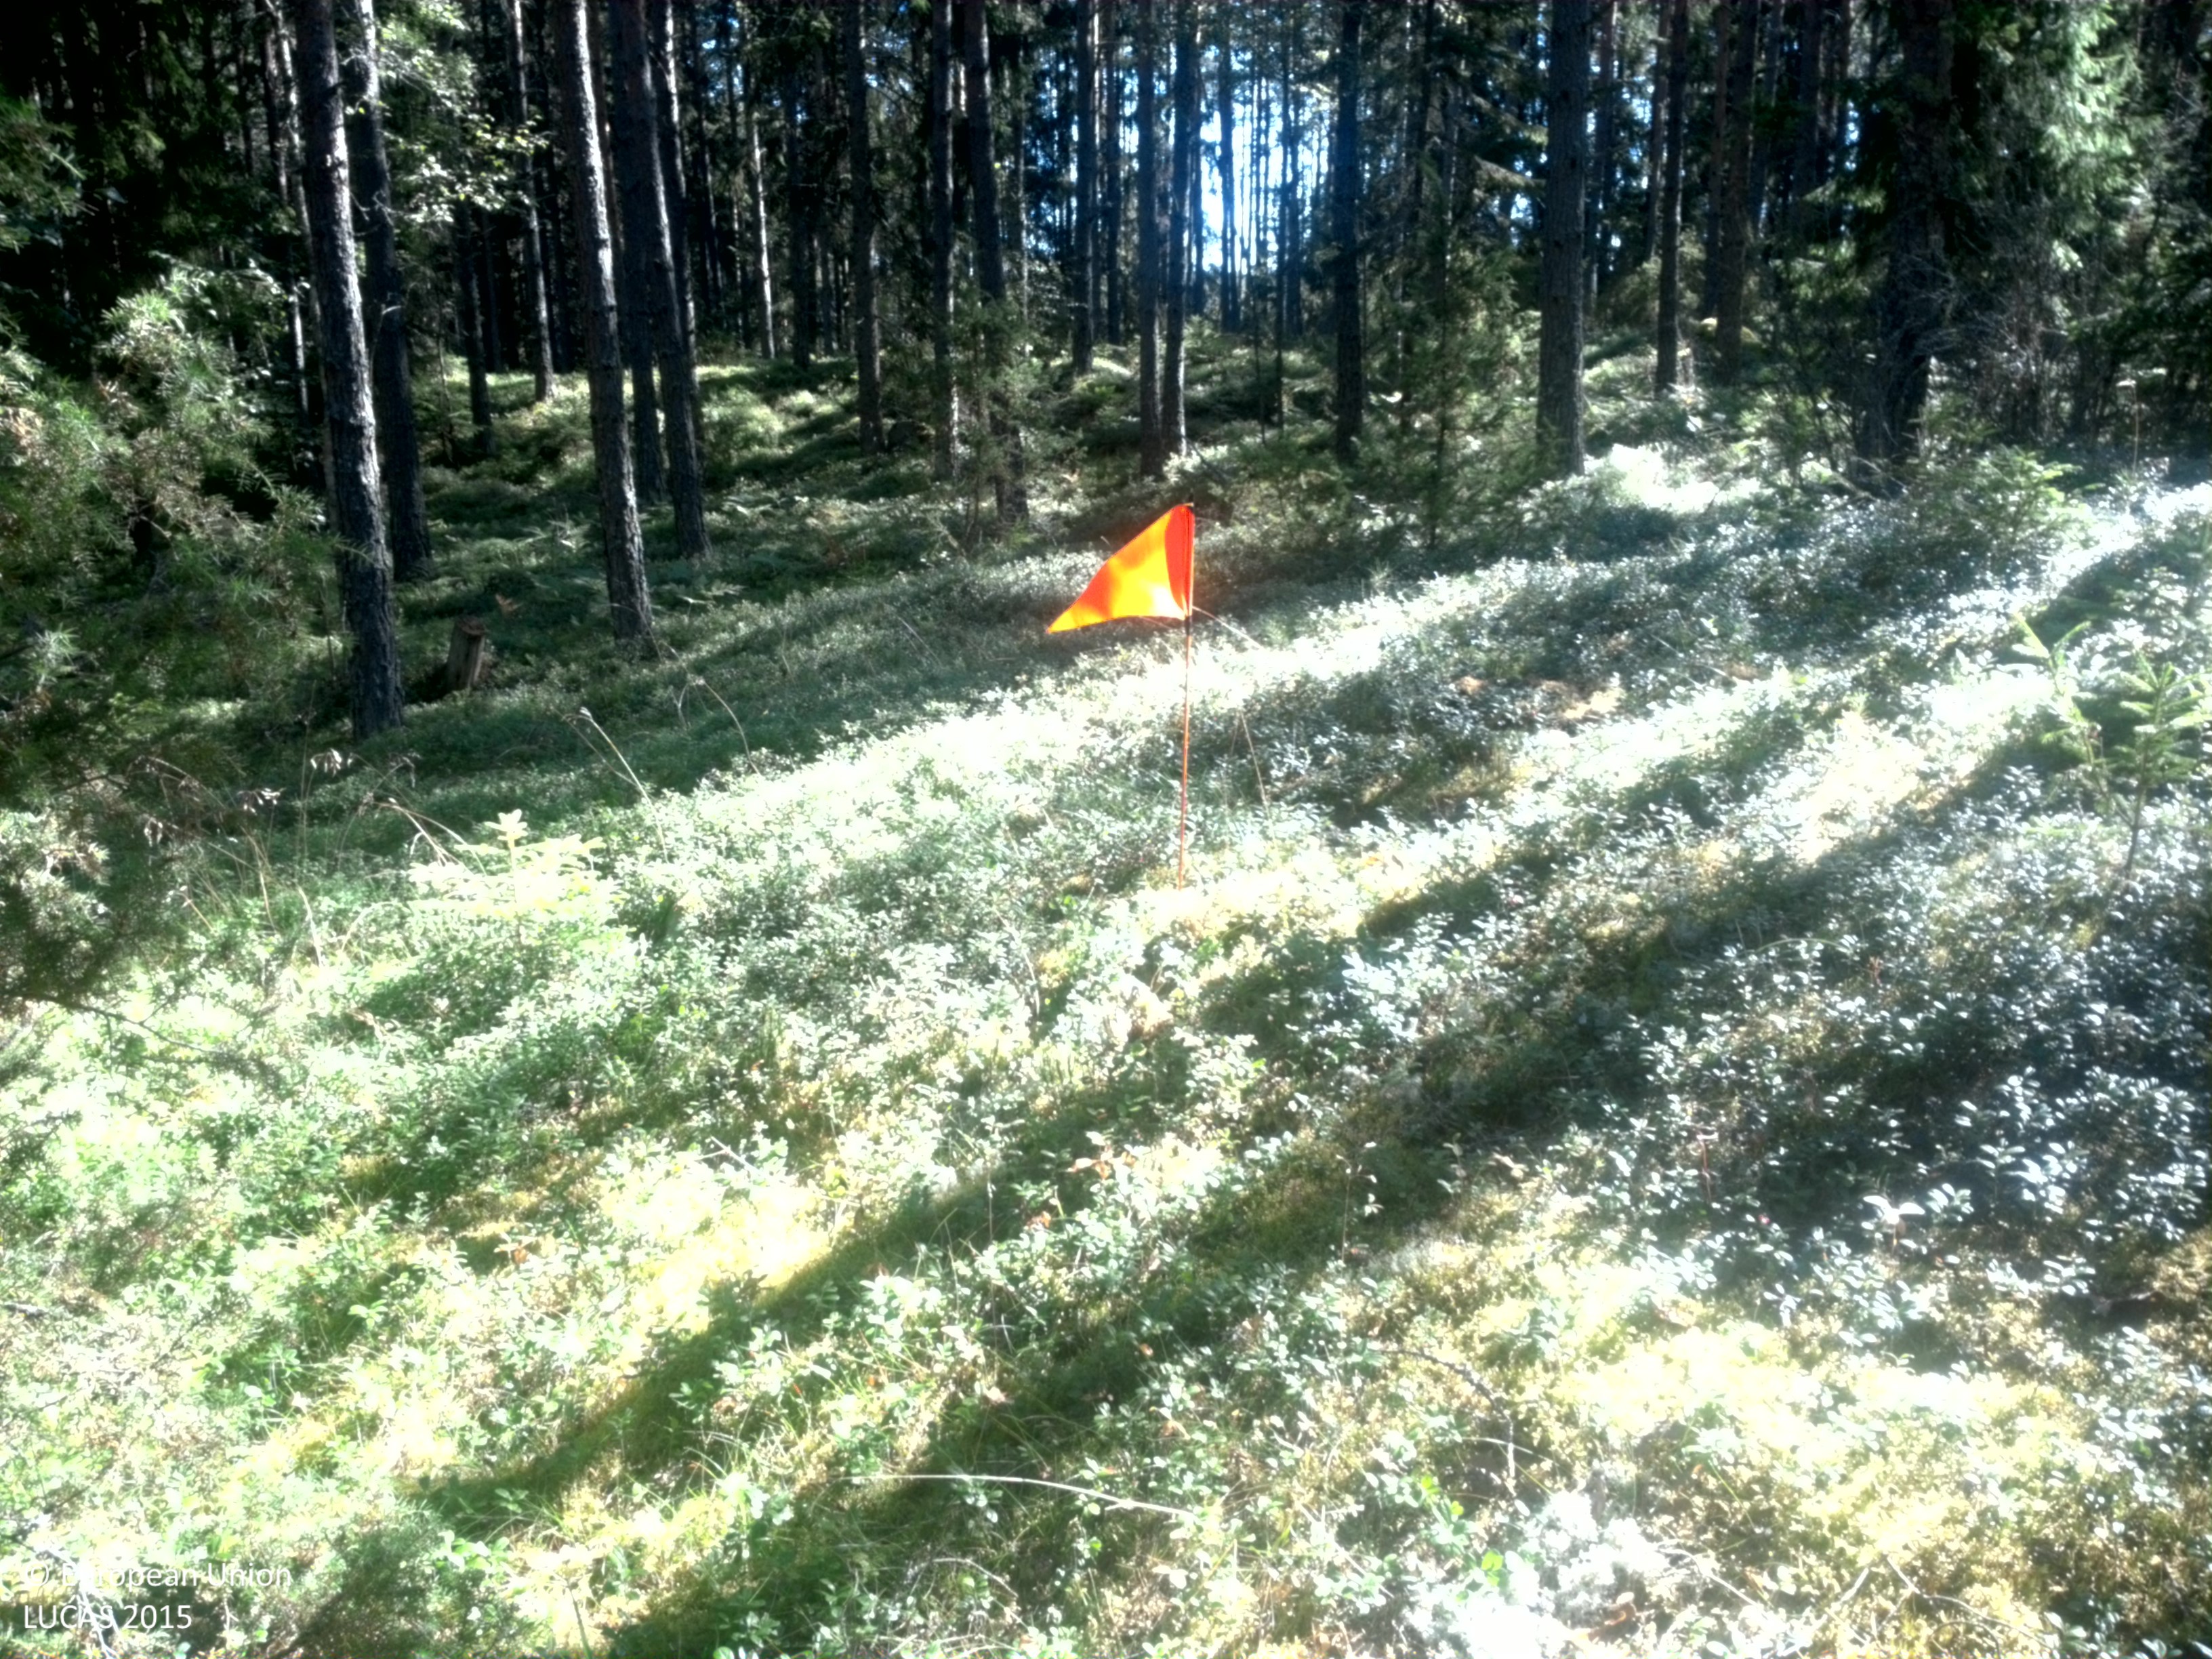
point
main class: Woodland
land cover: Pine dominated coniferous woodland
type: boreal forest
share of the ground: 50 - 75 %
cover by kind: coniferous forest trees 70 %, shrubs 25 %, lichens and mosses 5 %
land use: Forestry
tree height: > 5 m
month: August
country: SE
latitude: 59.7651
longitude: 17.1325
